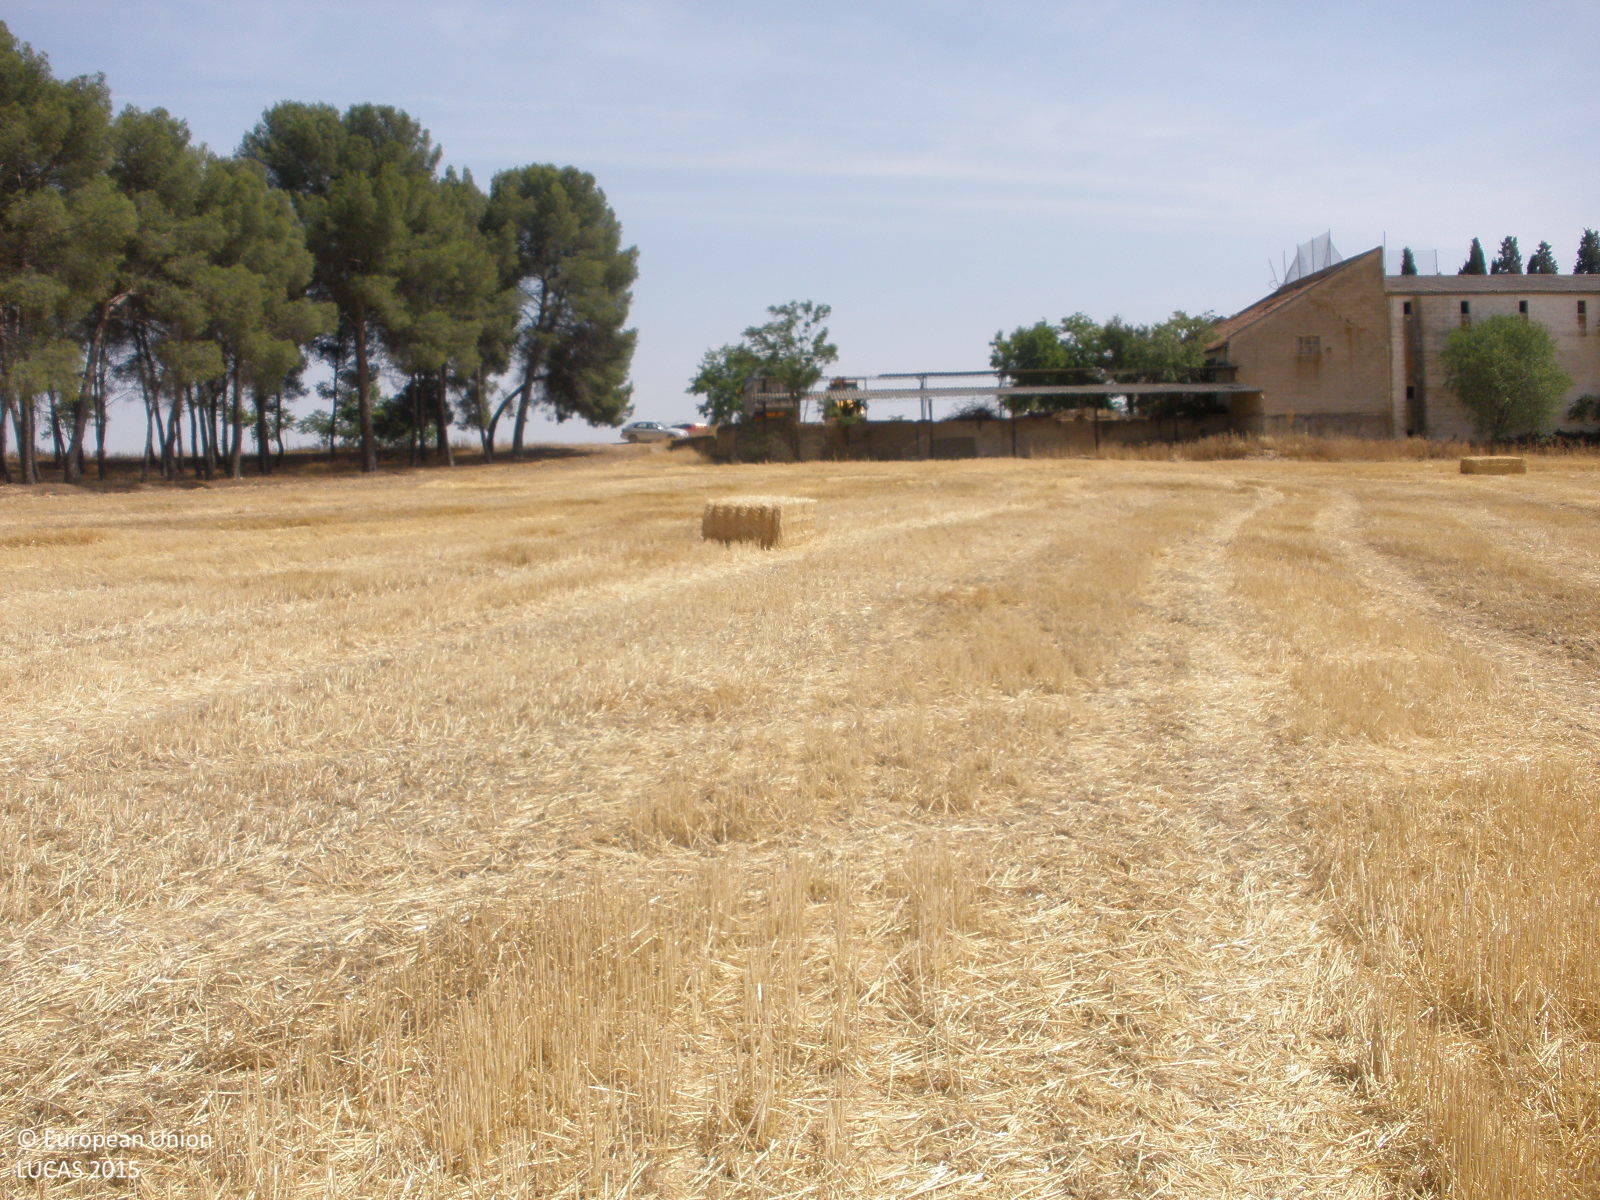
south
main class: Cropland
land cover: Common wheat
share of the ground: < 10 %
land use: Agriculture (excluding fallow land and kitchen gardens)
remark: Harvested field
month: July
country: ES
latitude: 40.3415
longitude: -3.4655
